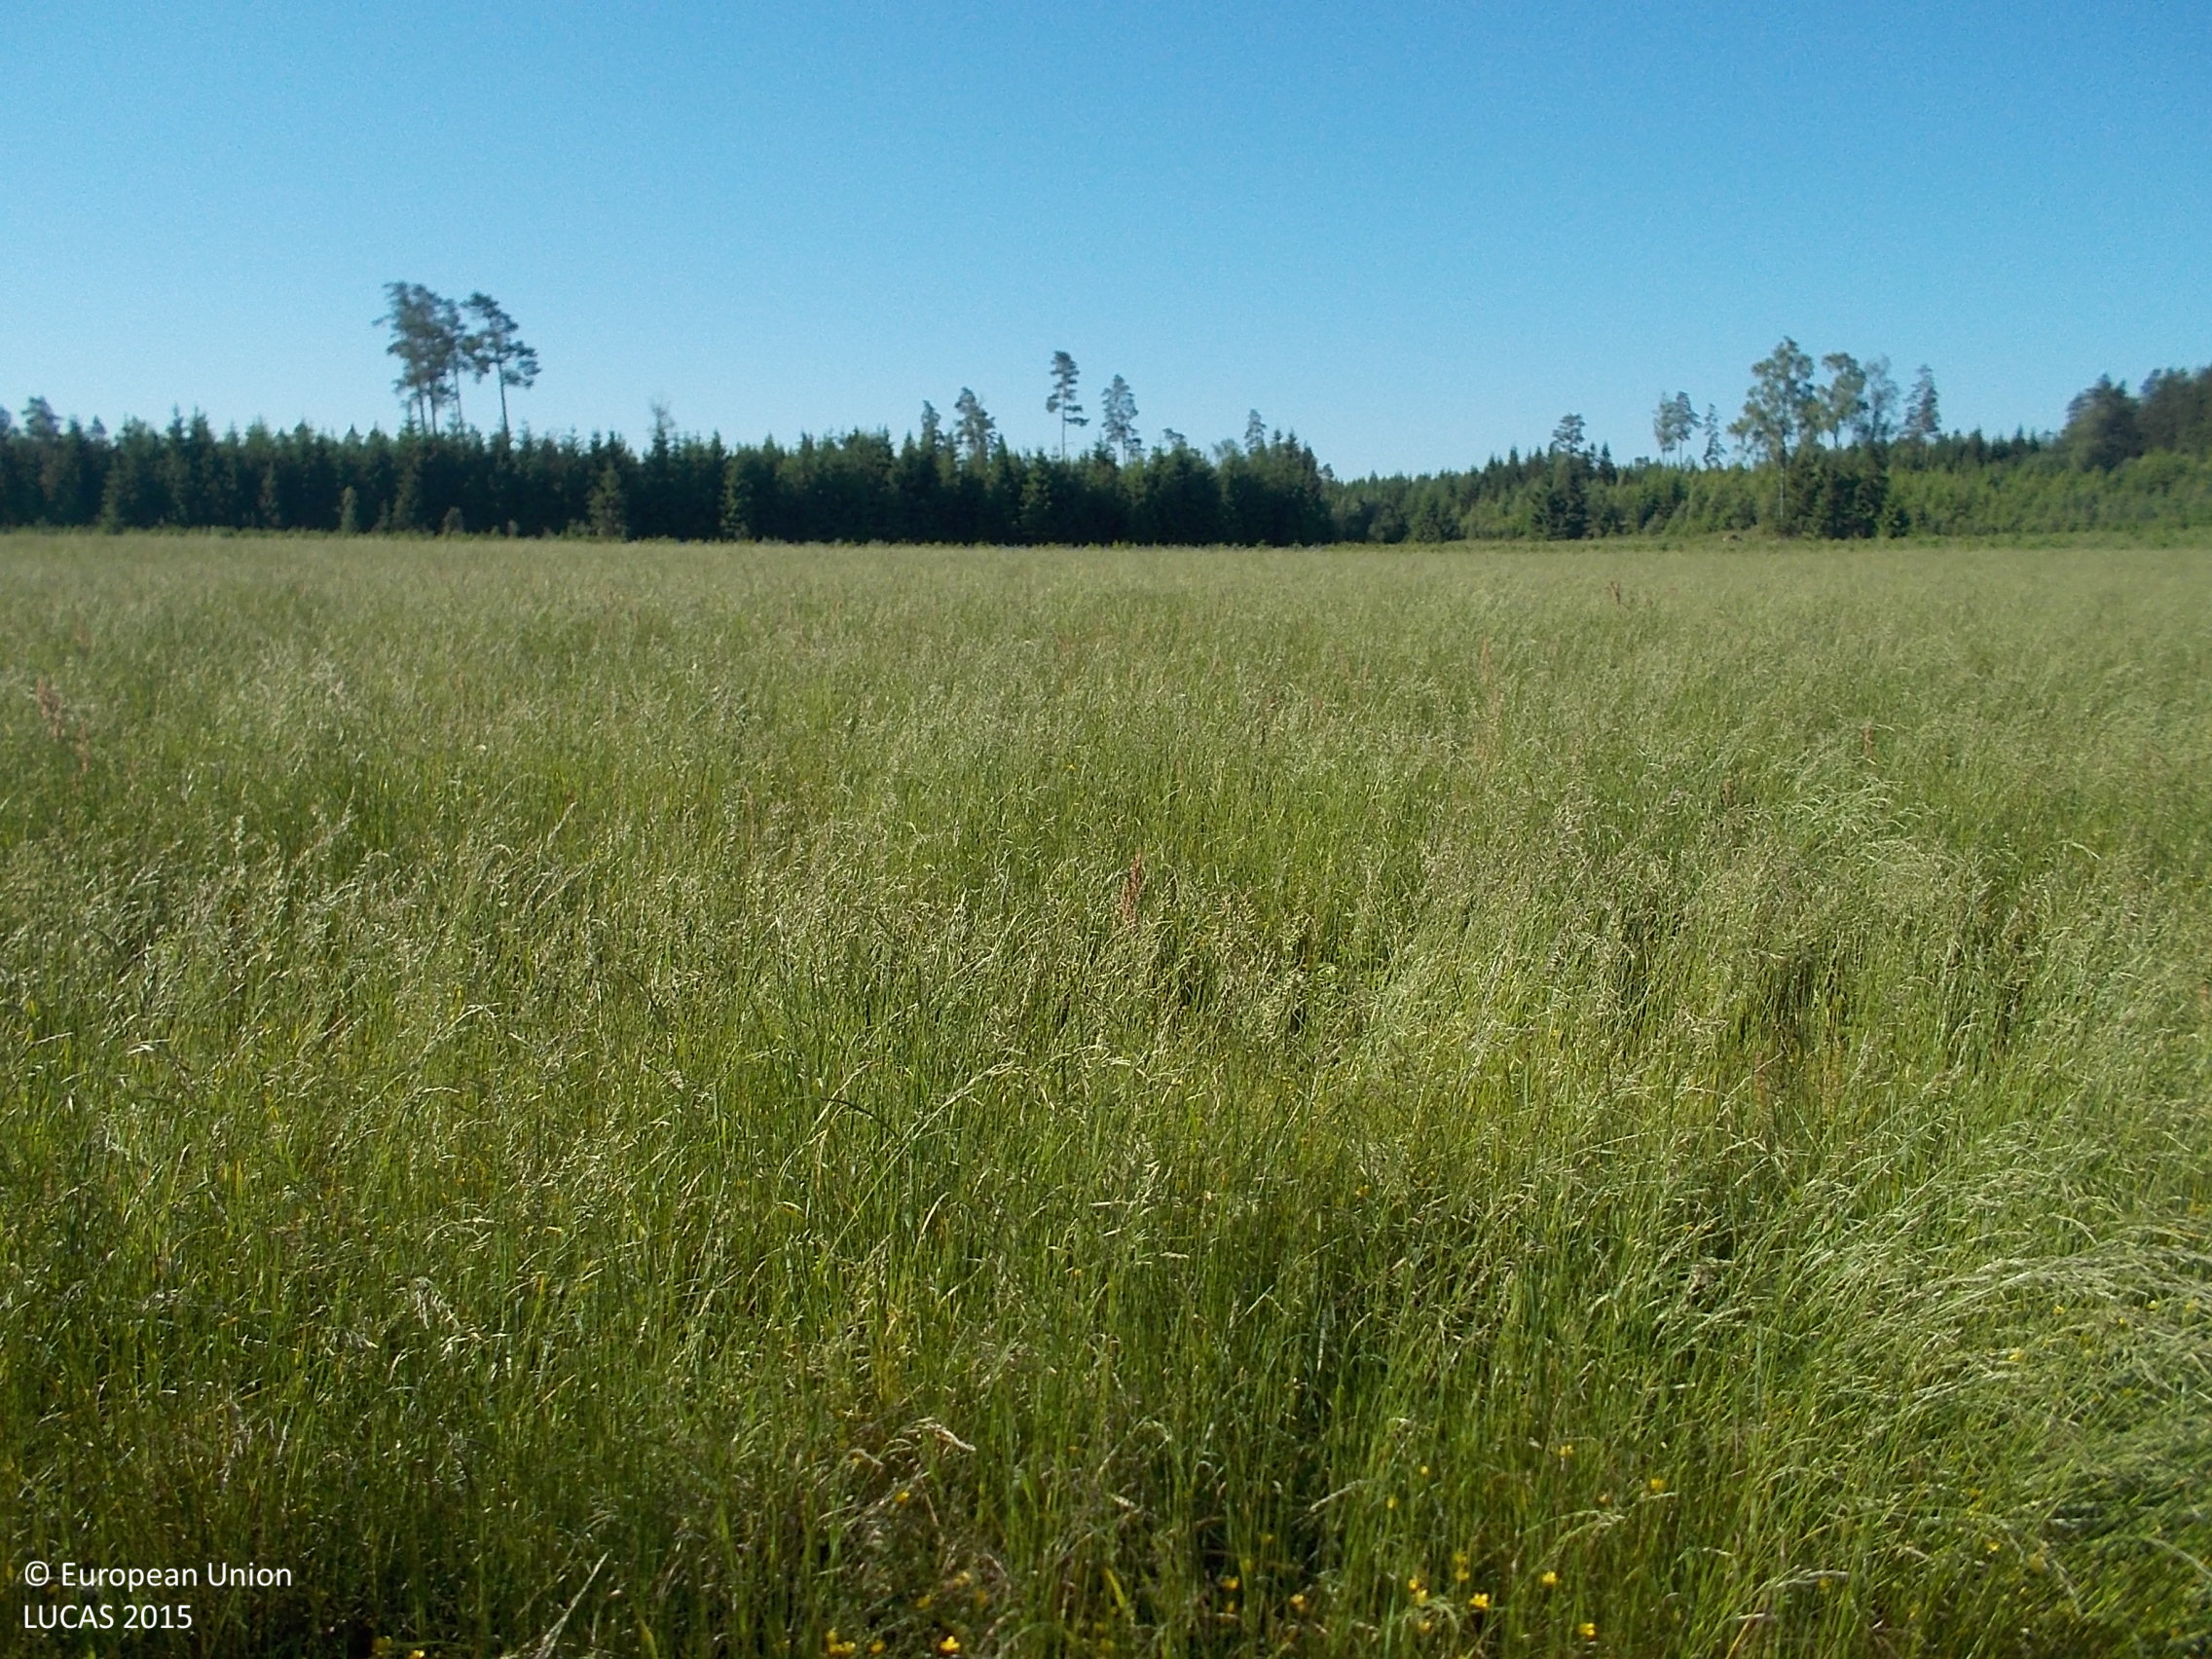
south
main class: Cropland
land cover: Temporary grasslands
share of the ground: > 75 %
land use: Agriculture (excluding fallow land and kitchen gardens)
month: July
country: SE
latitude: 57.2636
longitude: 13.1960
